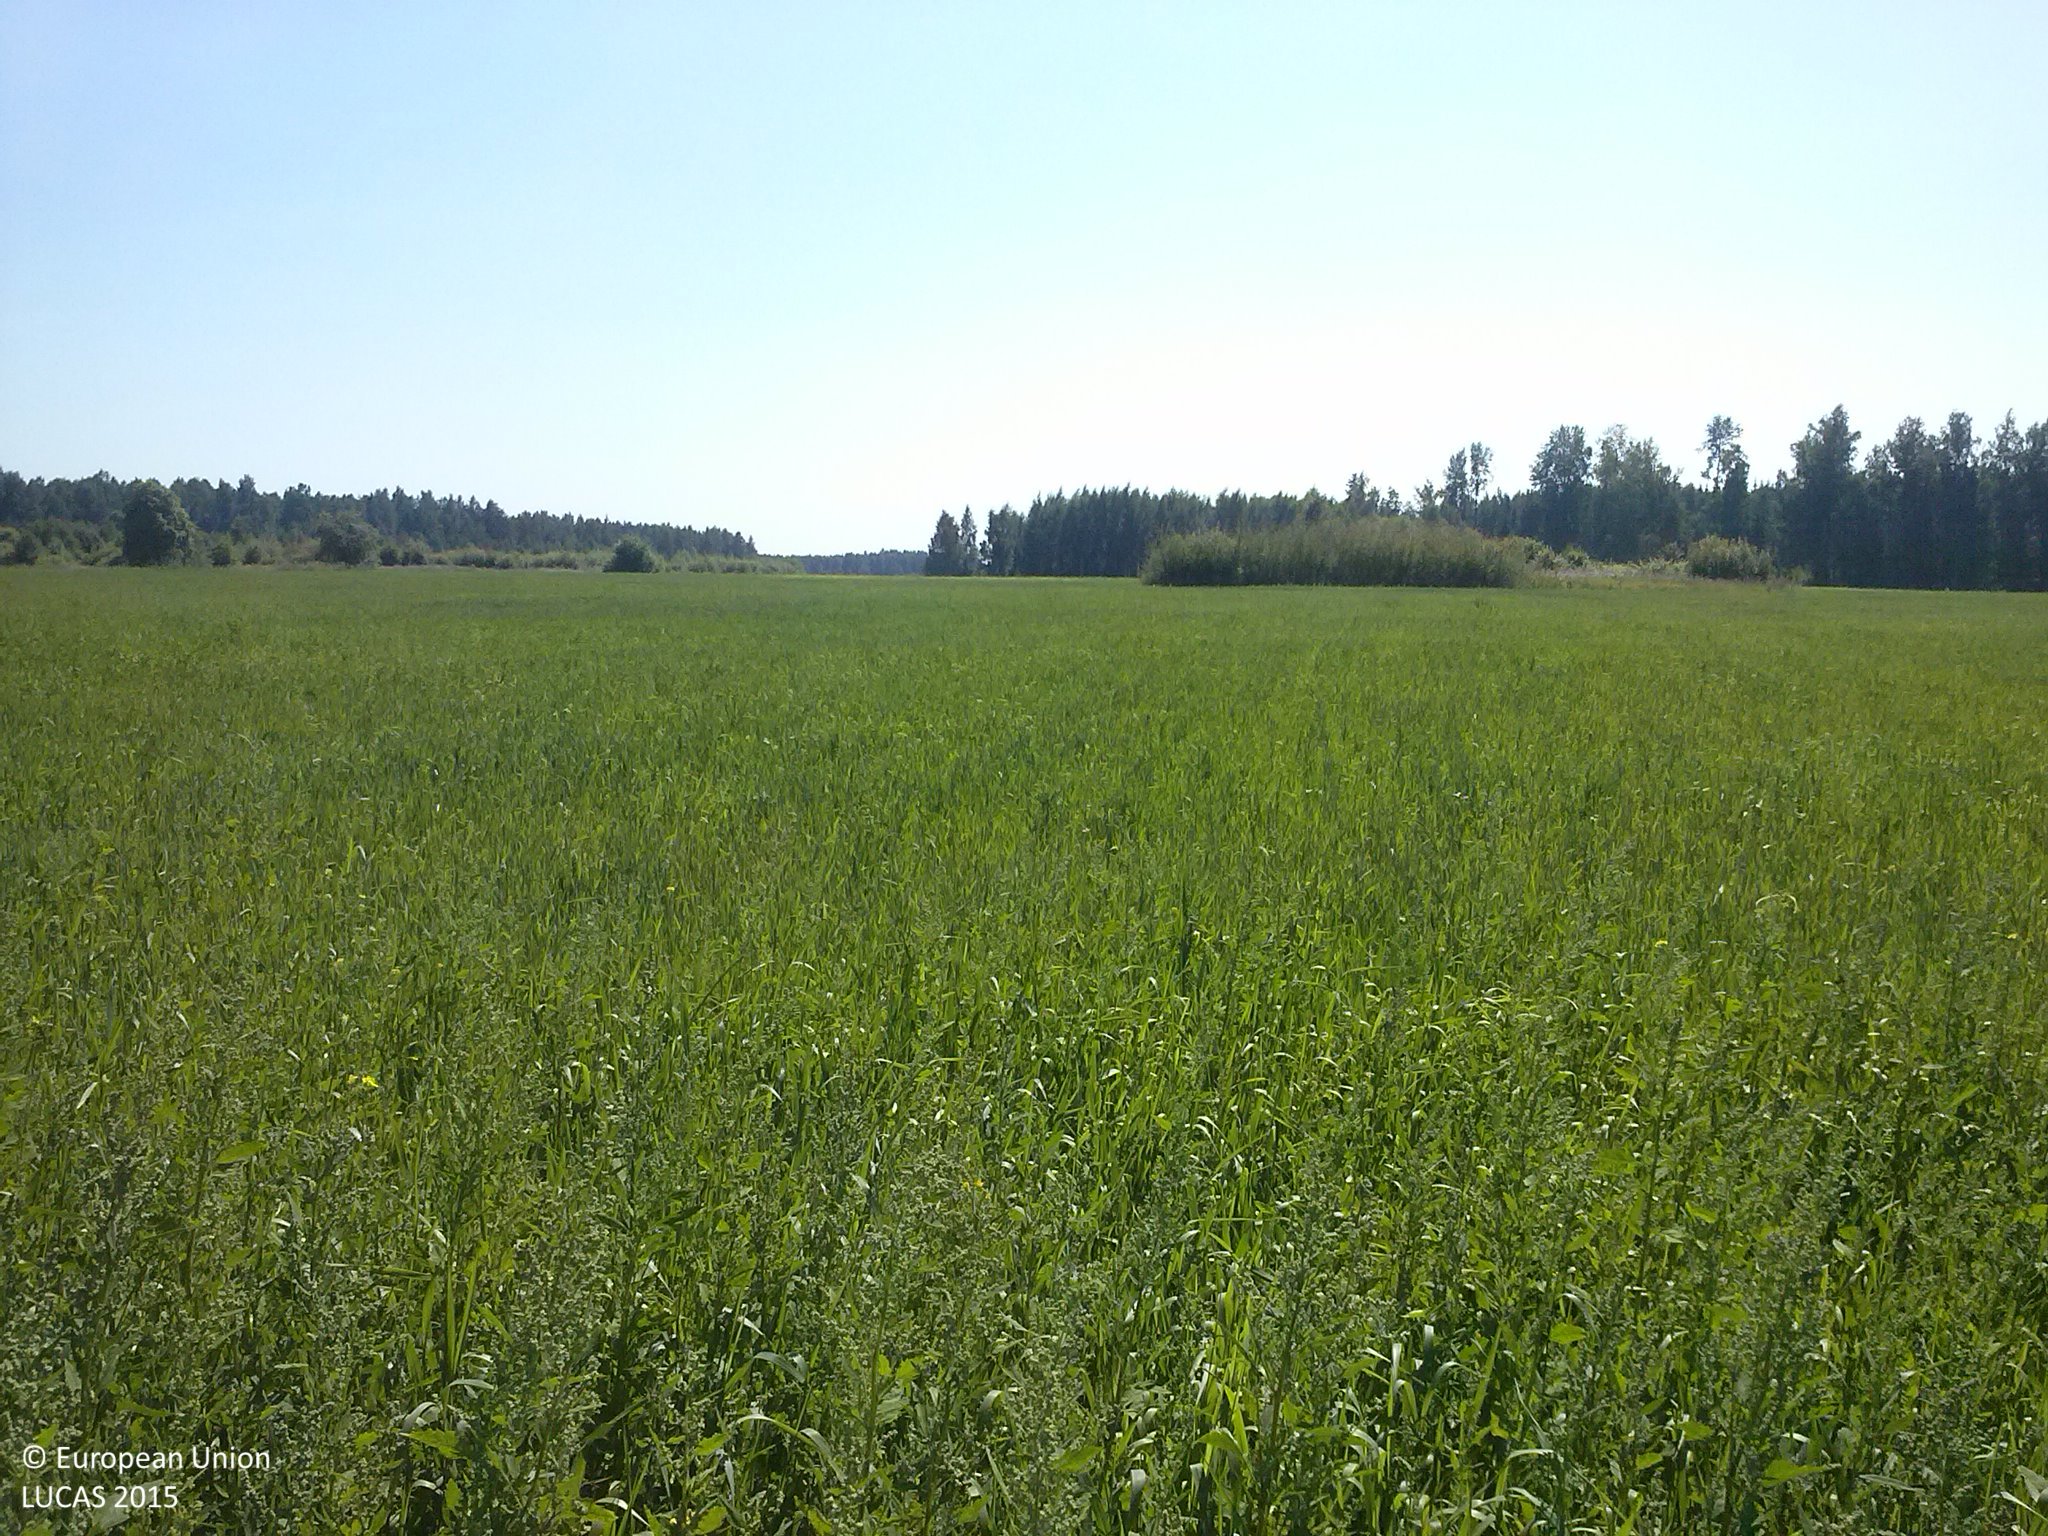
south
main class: Grassland
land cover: Grassland without tree/shrub cover
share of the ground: > 75 %
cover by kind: herbaceous plants 100 %
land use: Agriculture (excluding fallow land and kitchen gardens)
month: August
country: LV
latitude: 56.7344
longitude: 27.8270
